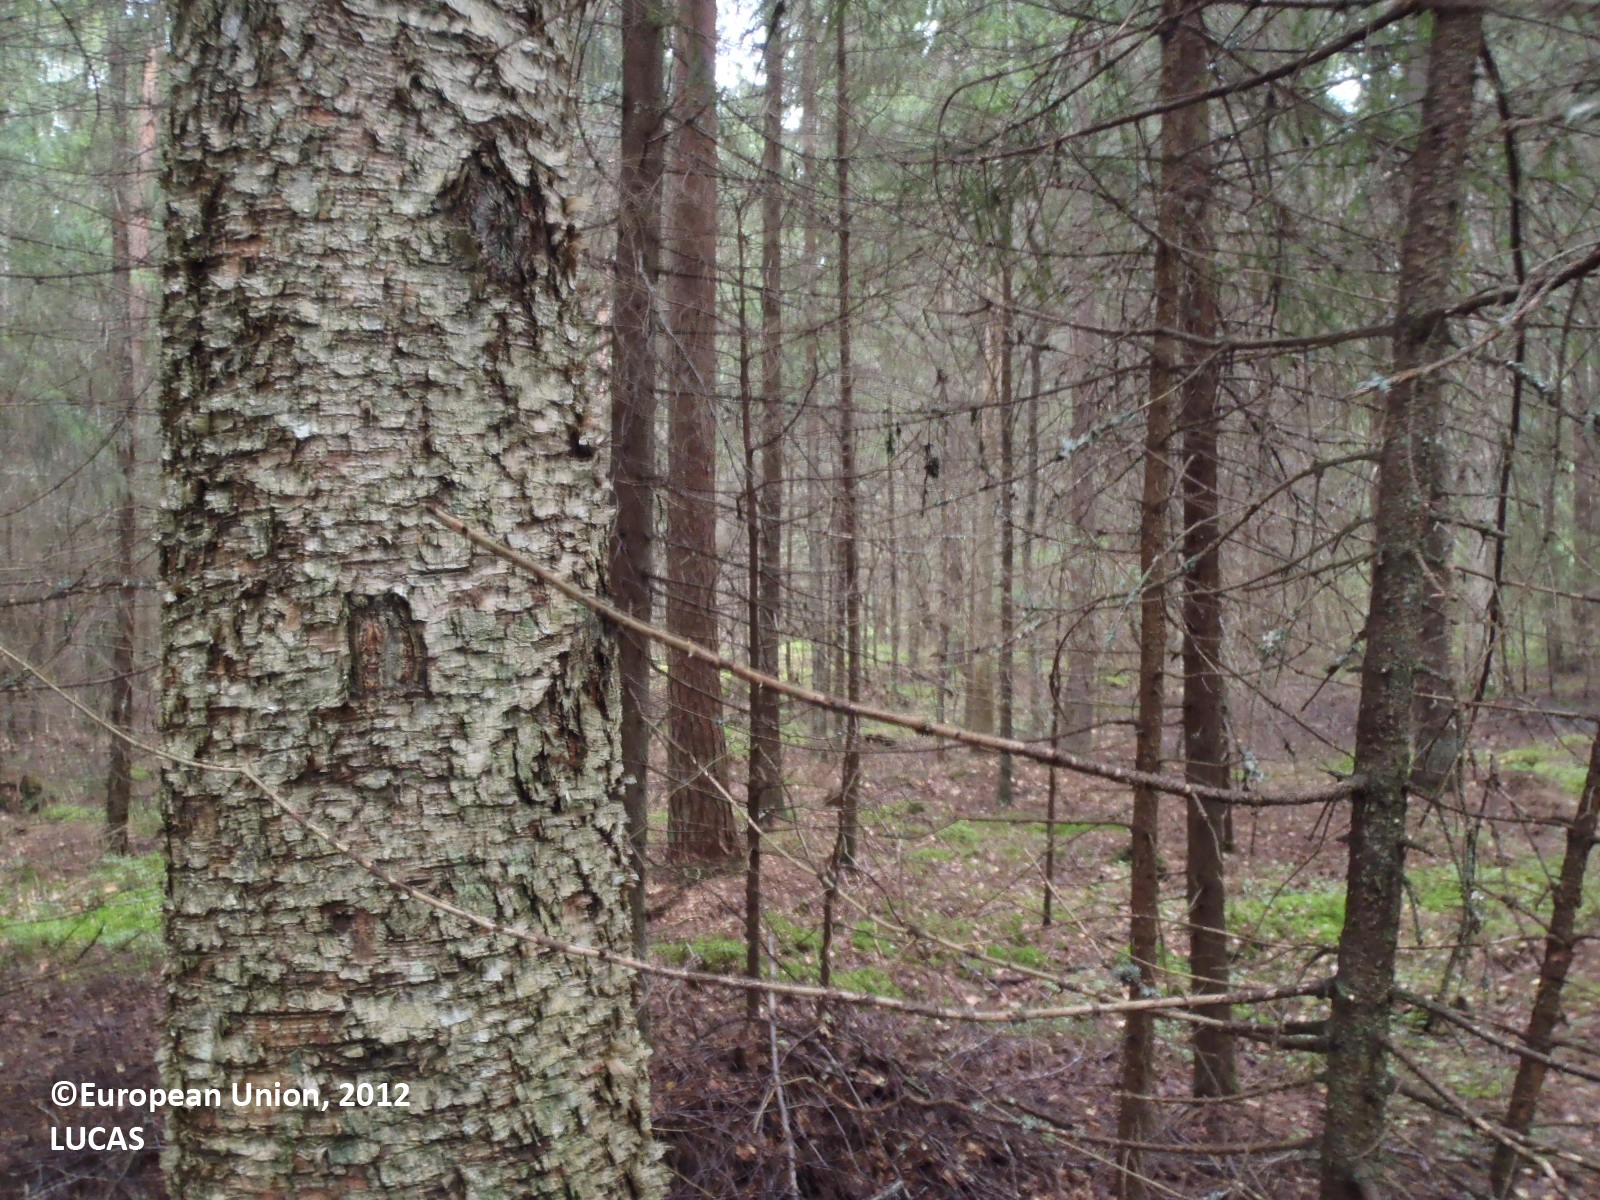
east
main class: Woodland
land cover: Spruce dominated coniferous woodland
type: boreal forest
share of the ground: > 75 %
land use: Forestry
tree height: > 5 m
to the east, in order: Spruce dominated coniferous woodland; Ditches and canals; Spruce dominated coniferous woodland; Ditches and canals; Tracks; Spruce dominated coniferous woodland; Ditches and canals; Grass margins; Barley
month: August
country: FI
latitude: 60.7545
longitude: 21.8584
